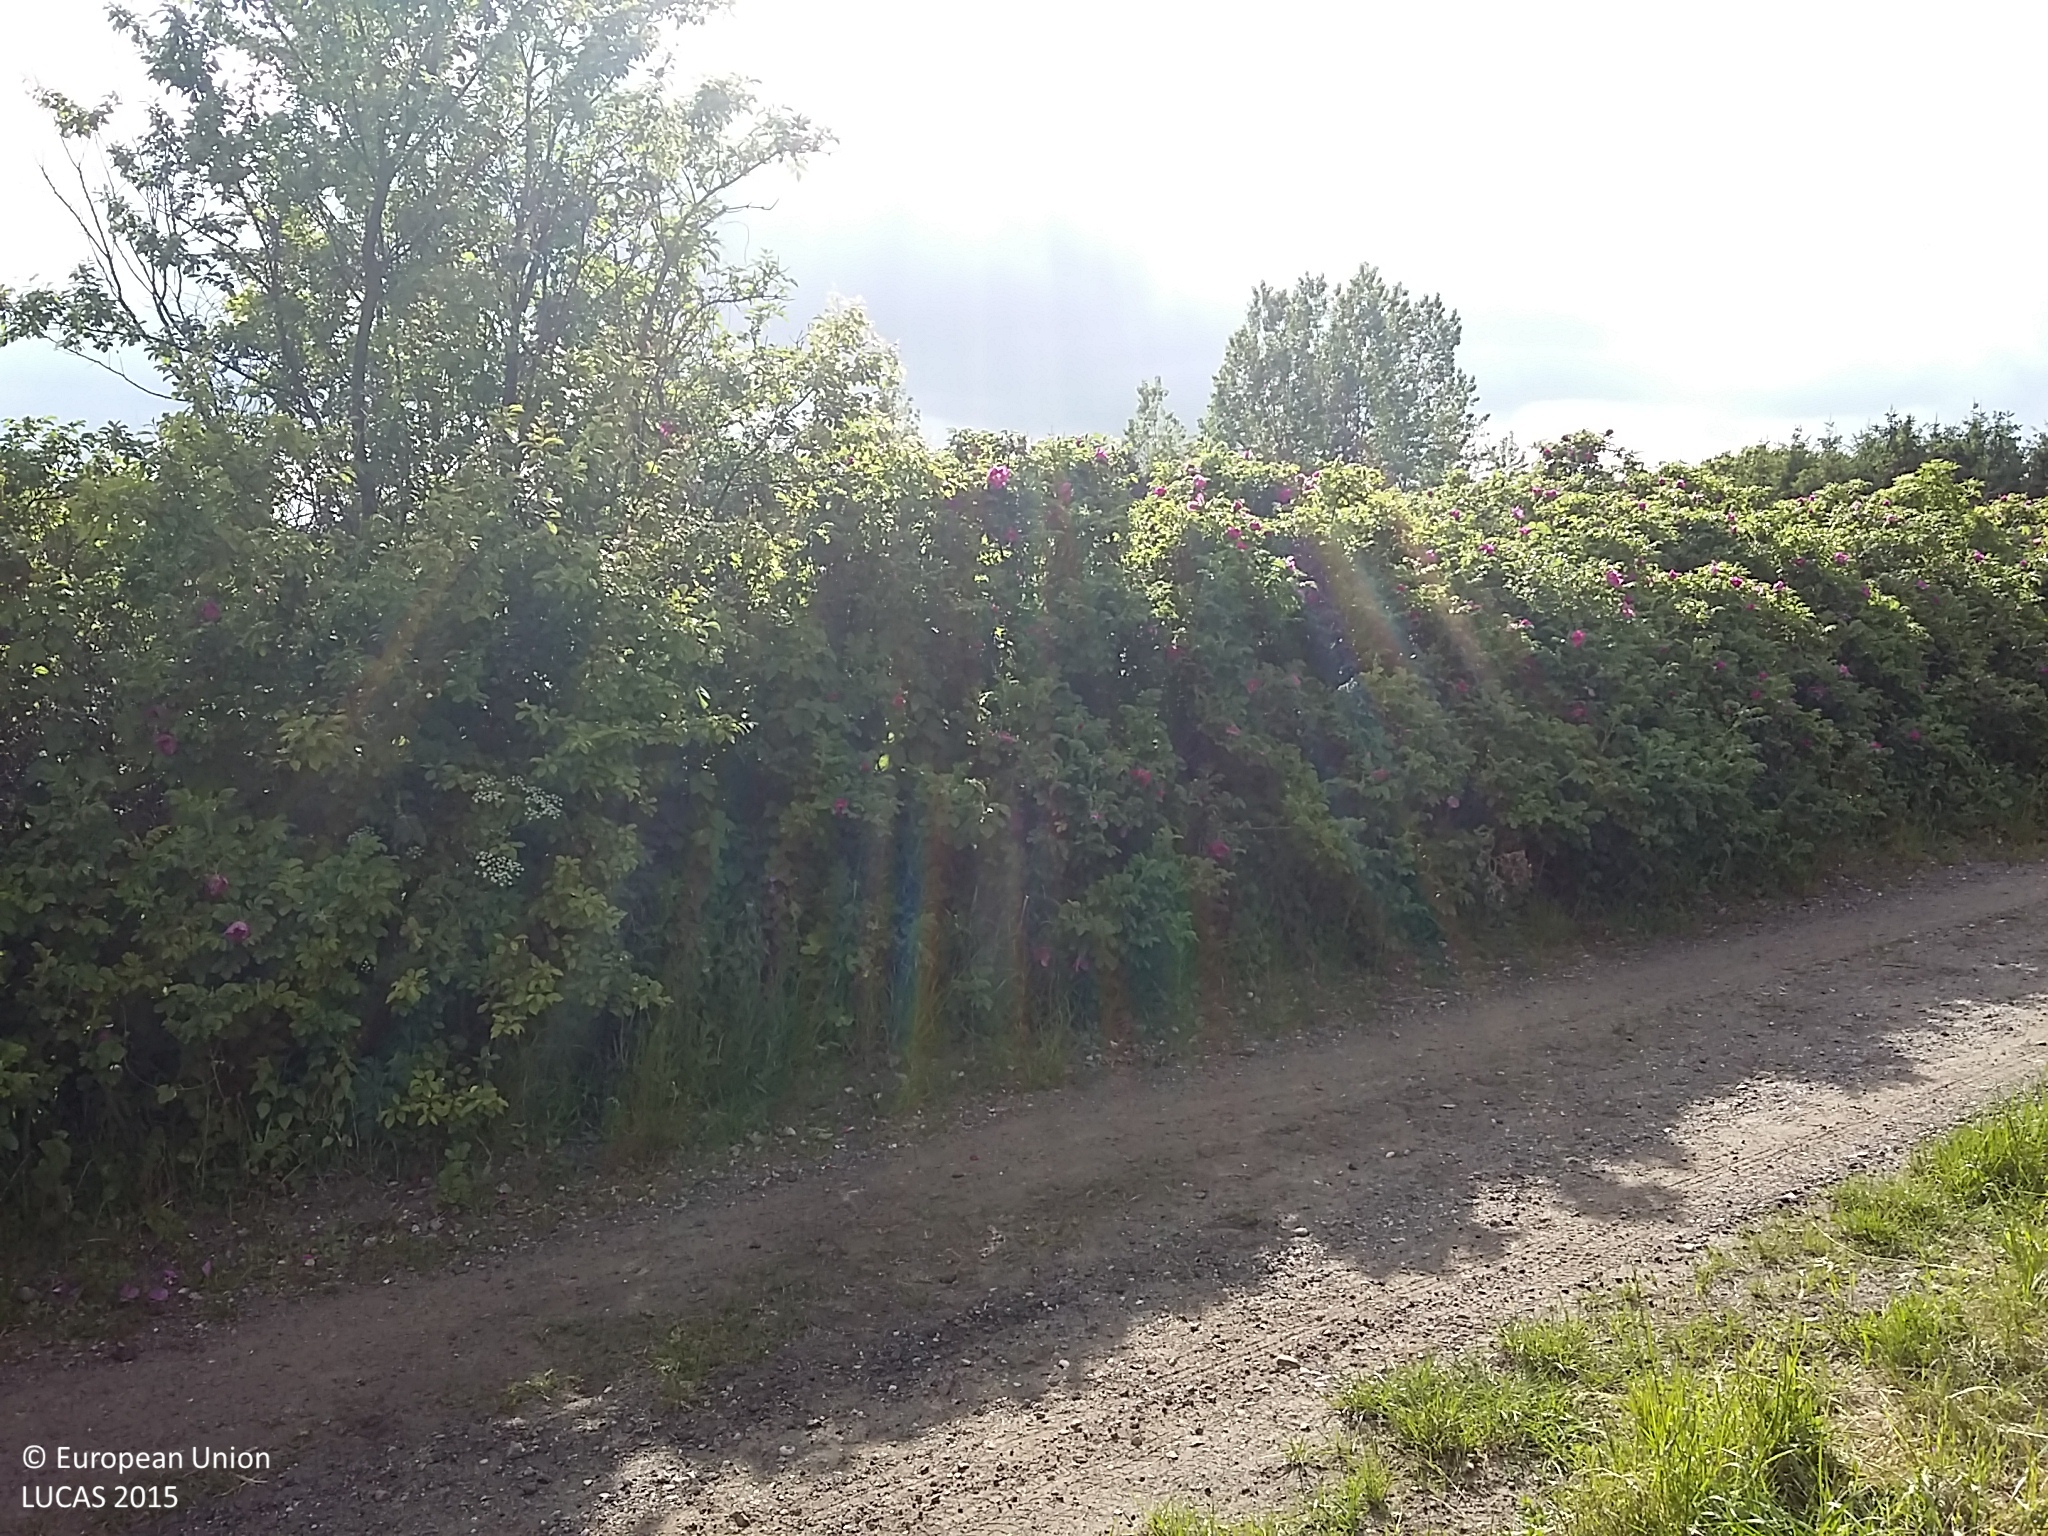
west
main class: Woodland
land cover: Broadleaved woodland
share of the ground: > 75 %
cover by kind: herbaceous plants 60 %, broadleaved forest trees 40 %
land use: Agriculture (excluding fallow land and kitchen gardens)
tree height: > 5 m
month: June
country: DK
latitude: 55.3408
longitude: 10.7404
